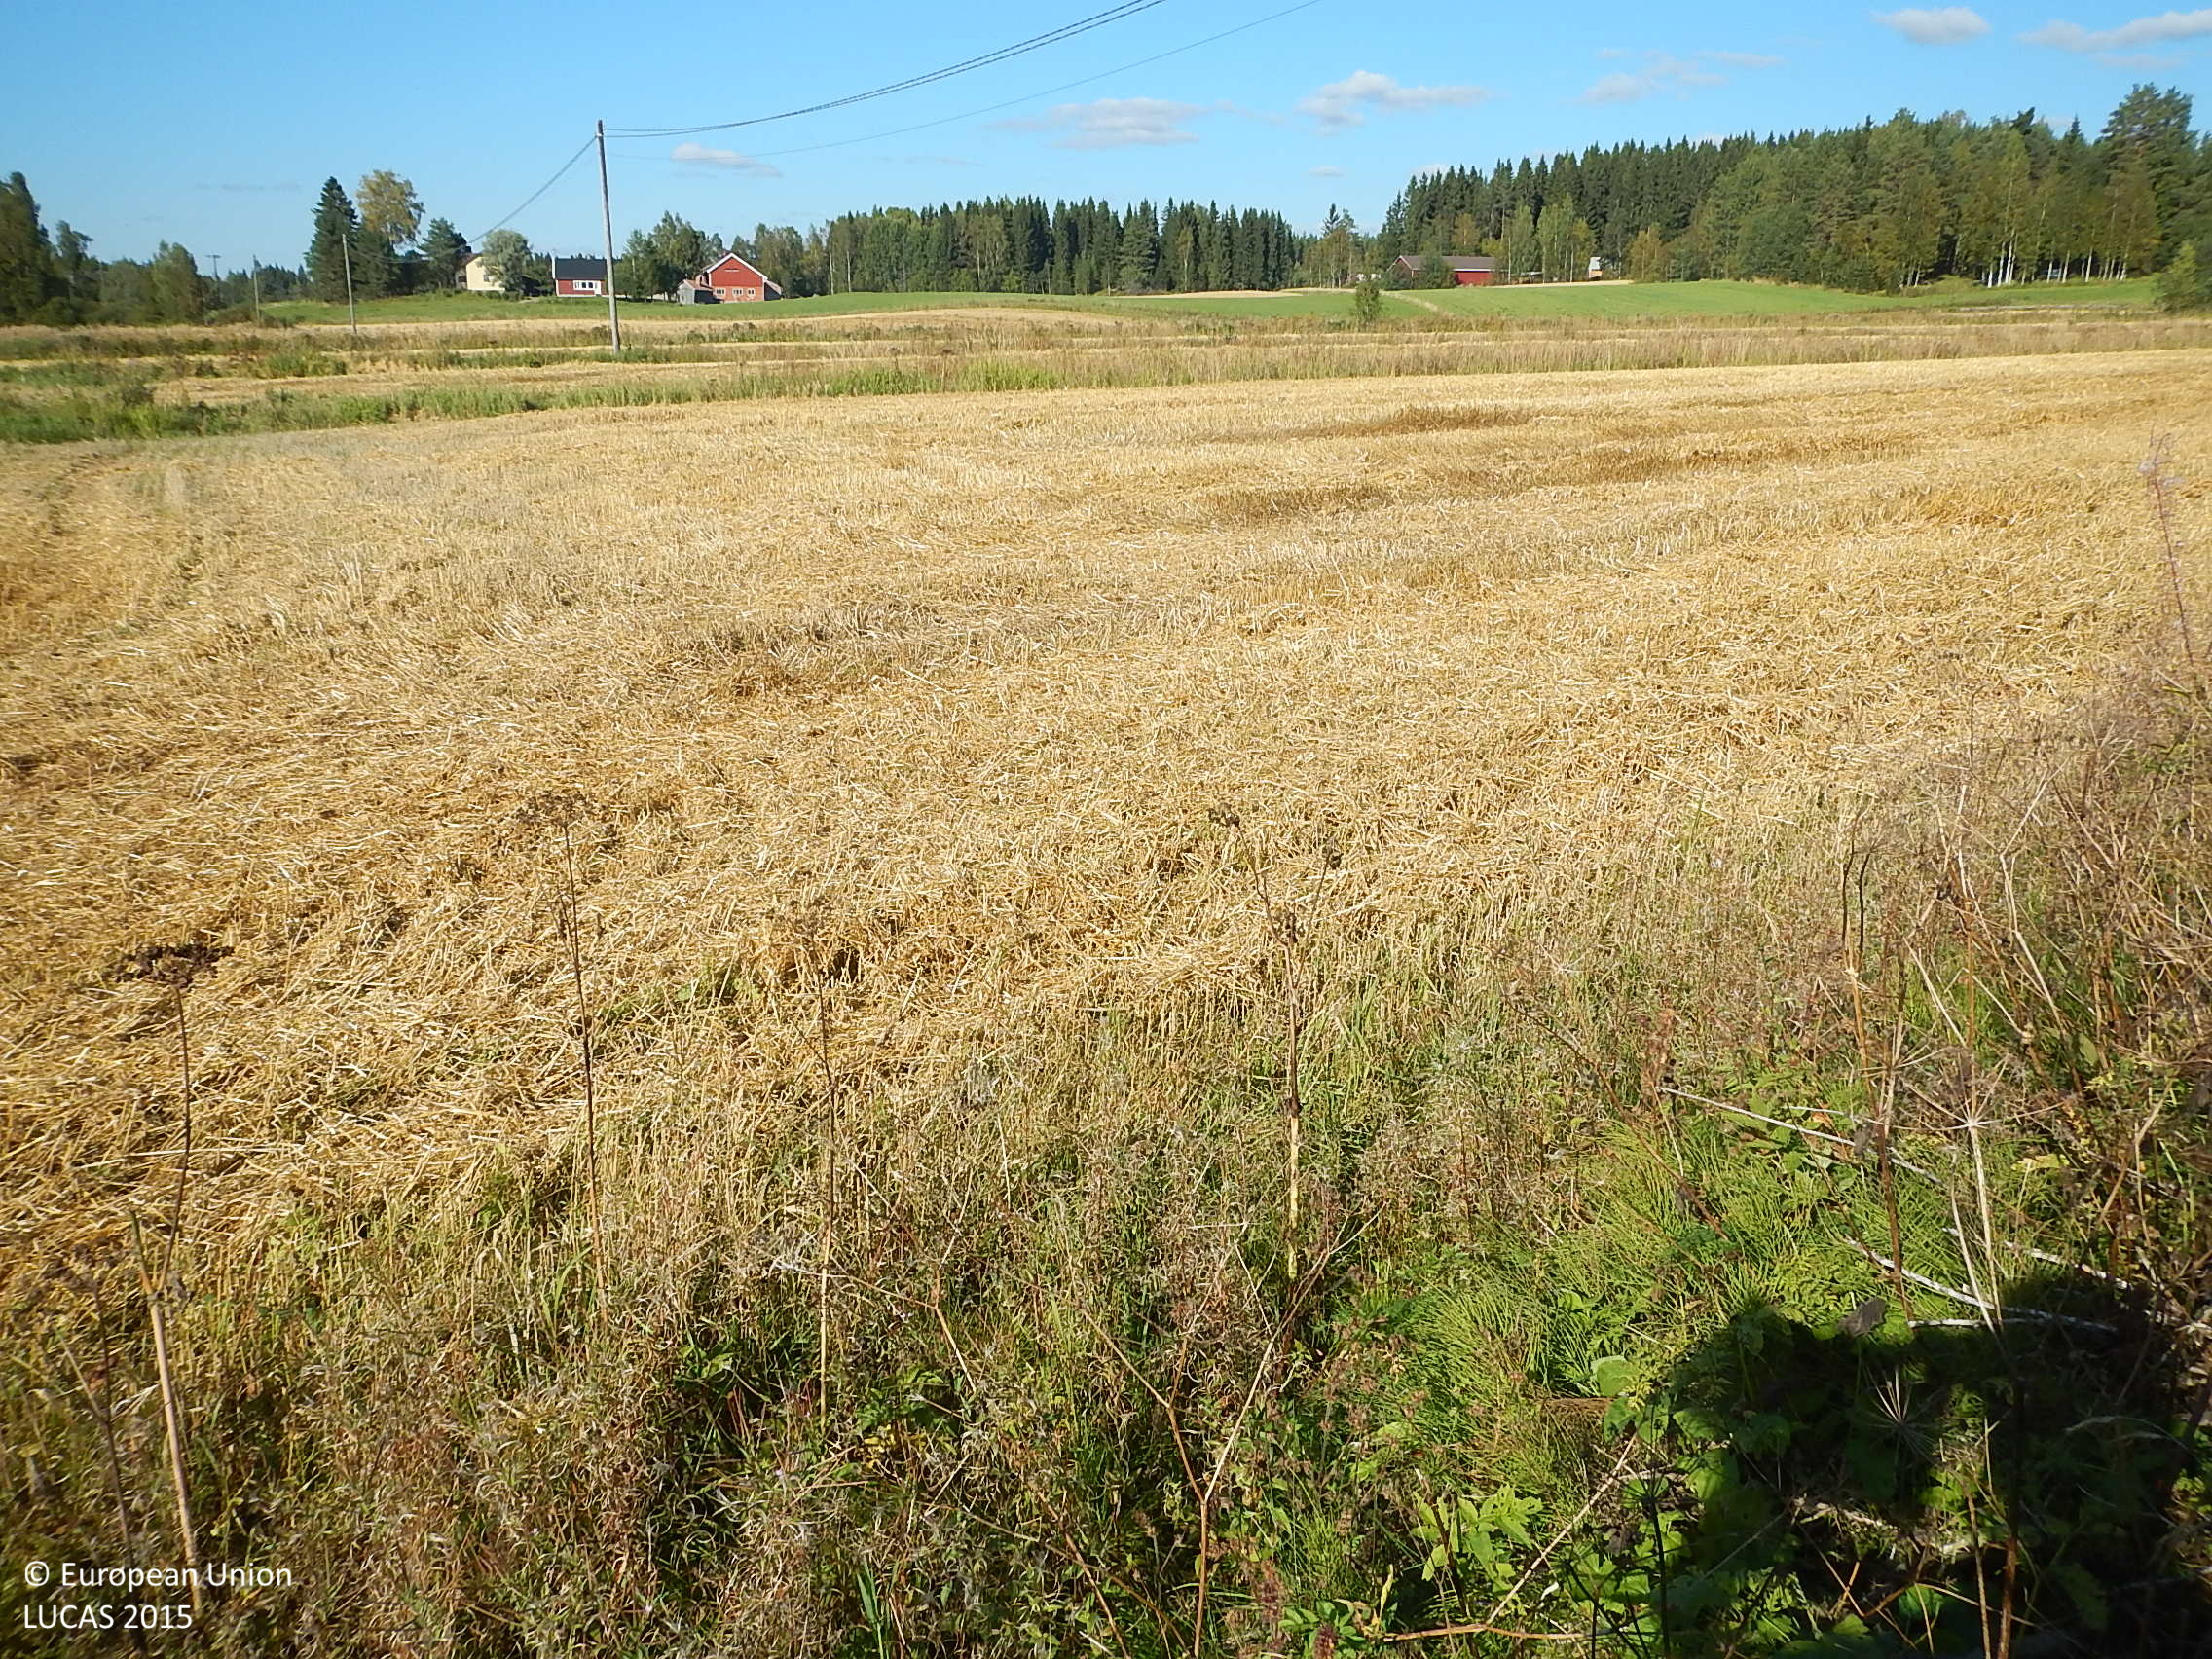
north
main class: Grassland
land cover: Spontaneously vegetated surfaces
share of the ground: > 75 %
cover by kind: herbaceous plants 100 %
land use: Semi-natural and natural areas not in use
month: September
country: FI
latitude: 61.6450
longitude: 22.7690
